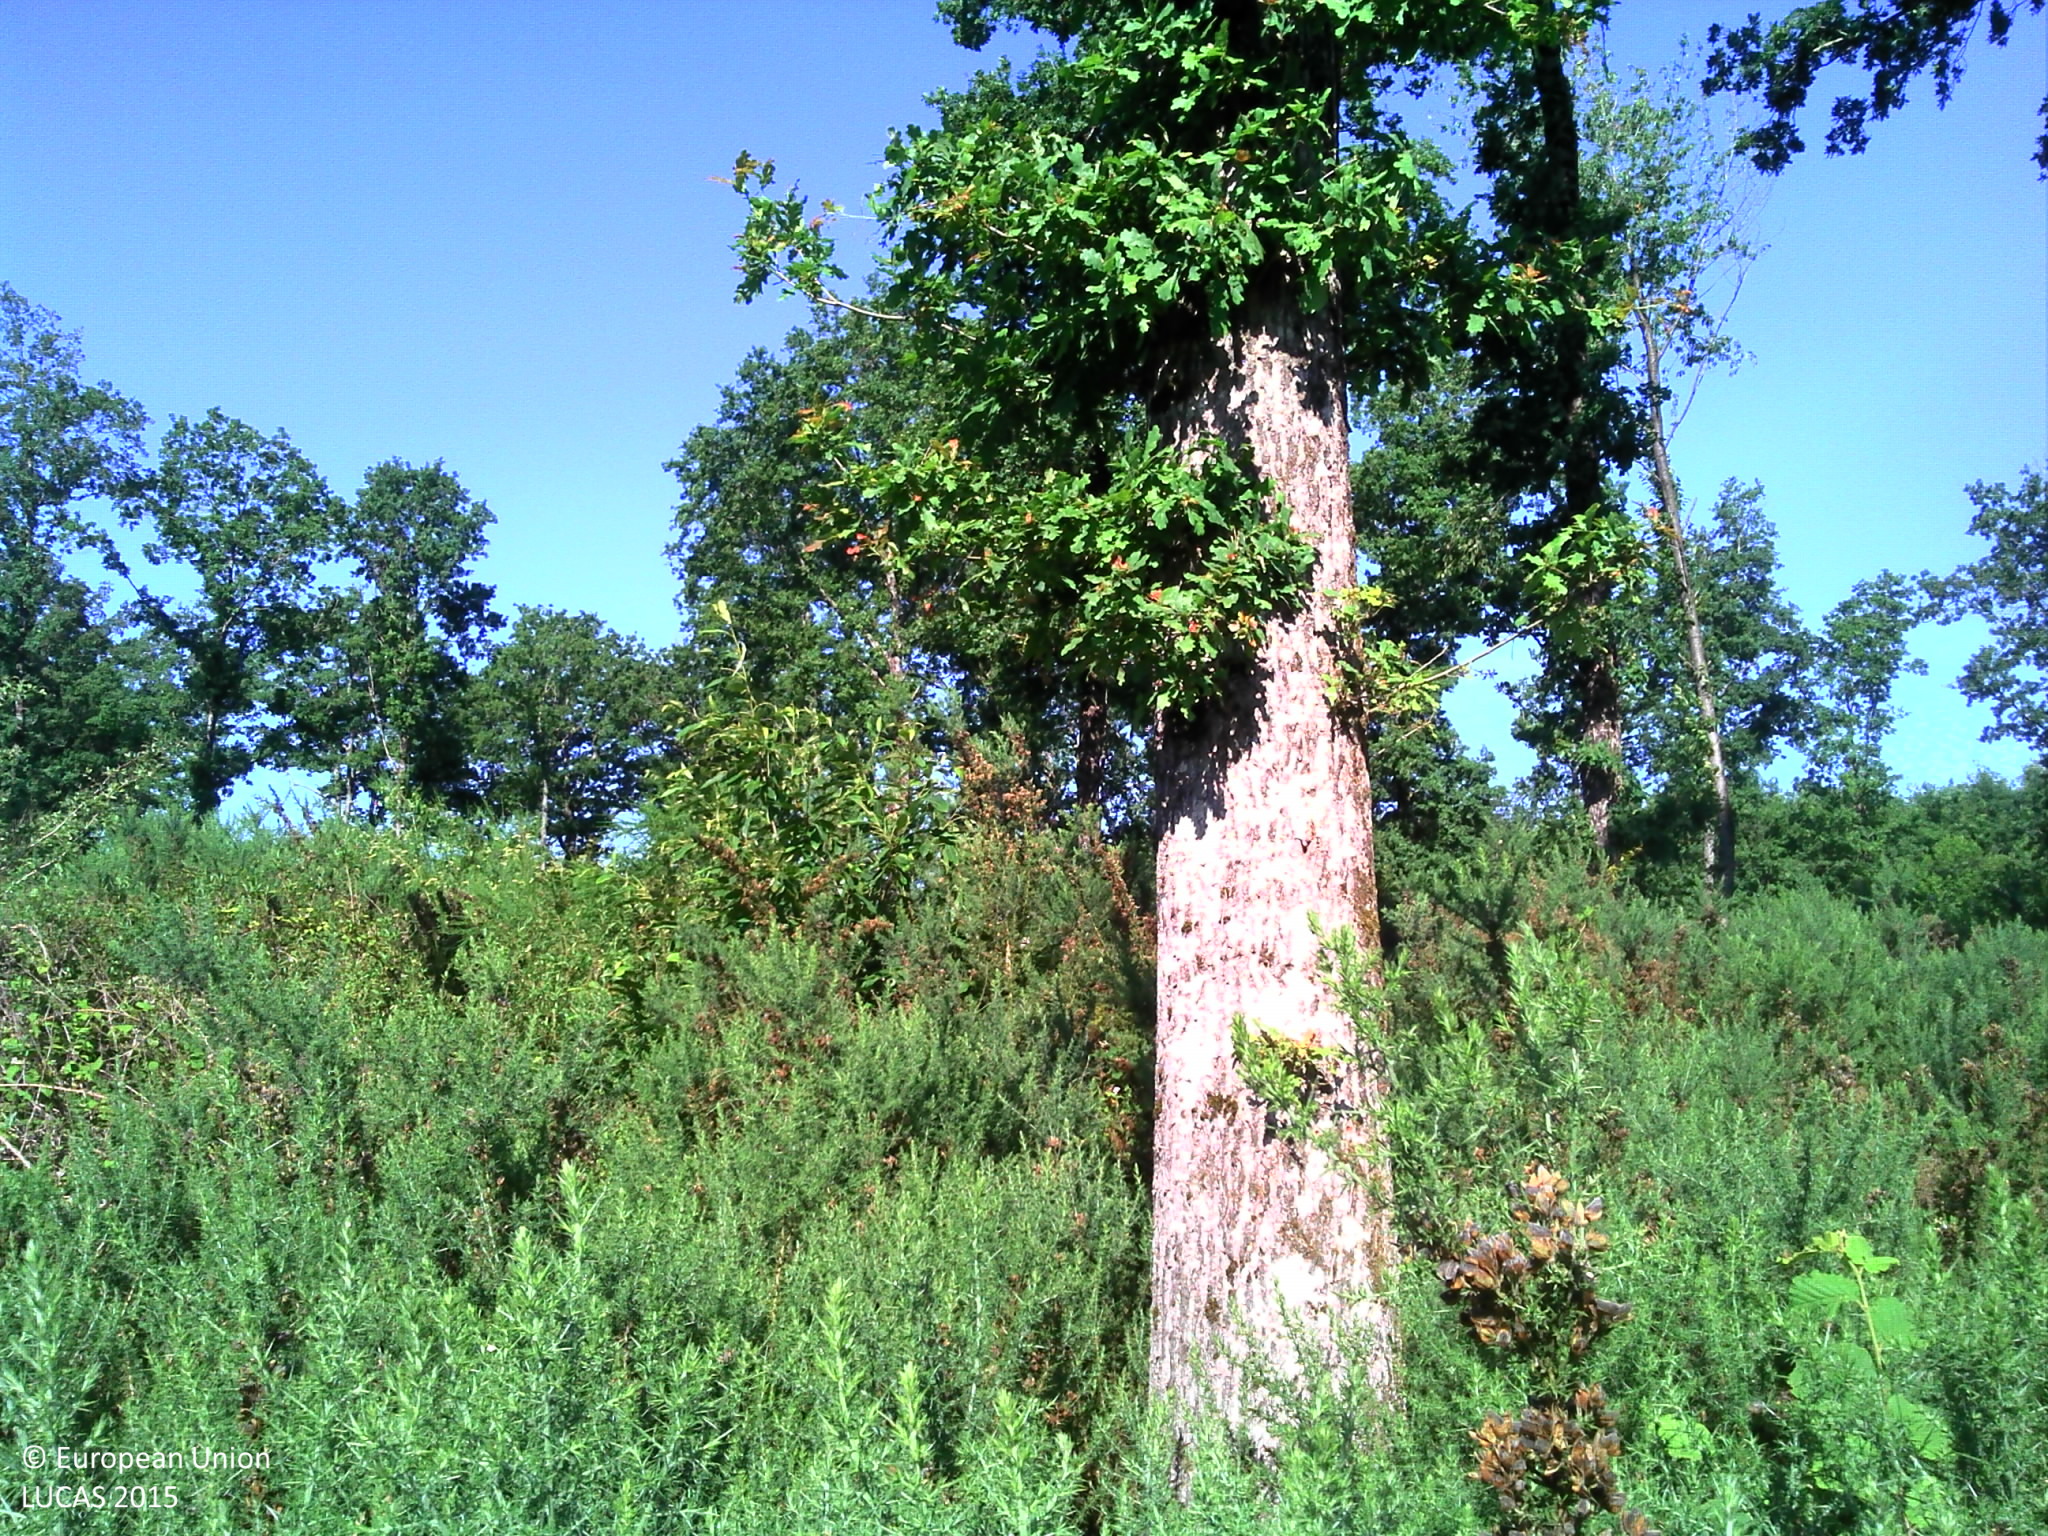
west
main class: Woodland
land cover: Broadleaved woodland
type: thermophilous deciduous forest
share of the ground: > 75 %
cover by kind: shrubs 45 %, broadleaved forest trees 35 %, herbaceous plants 15 %, lichens and mosses 5 %
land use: Semi-natural and natural areas not in use
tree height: > 5 m
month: June
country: FR
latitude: 45.8654
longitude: 0.4139
